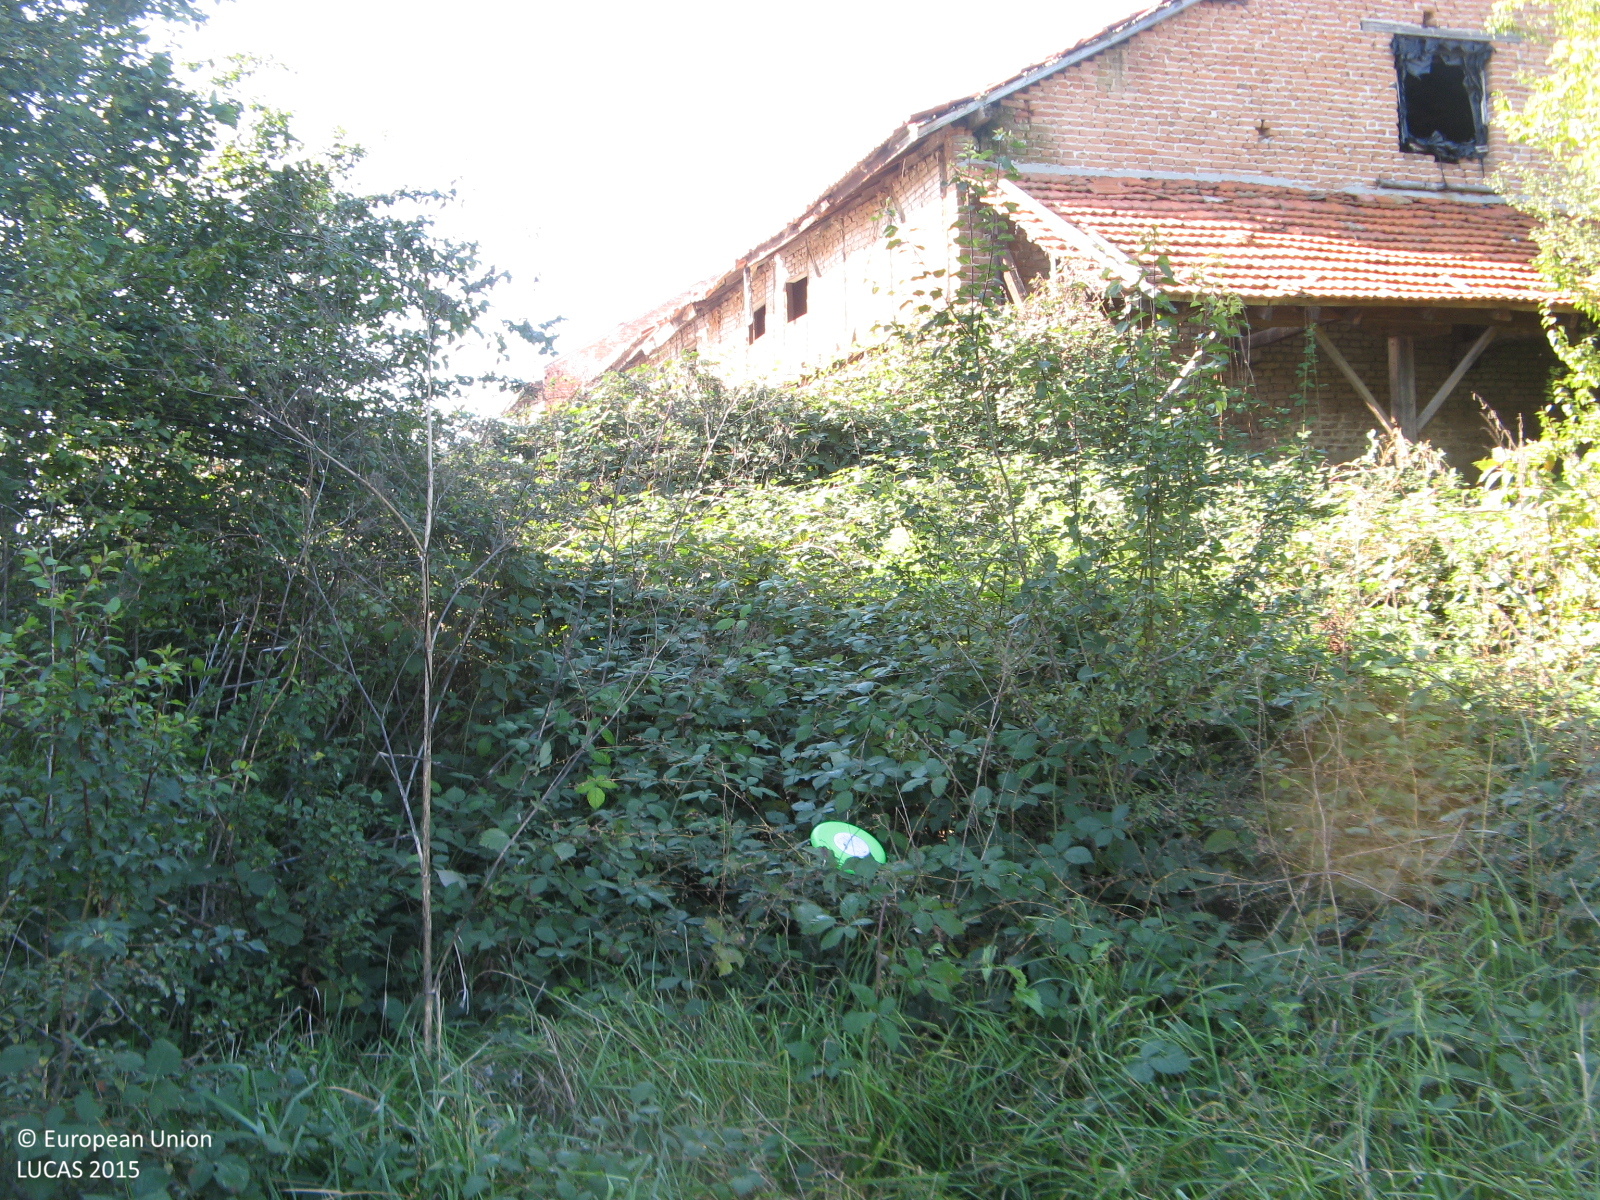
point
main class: Shrubland
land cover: Shrubland with sparse tree cover
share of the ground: > 75 %
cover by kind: shrubs 85 %, herbaceous plants 10 %, broadleaved forest trees 5 %
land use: Semi-natural and natural areas not in use
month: November
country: BG
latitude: 41.9796
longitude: 25.0568
